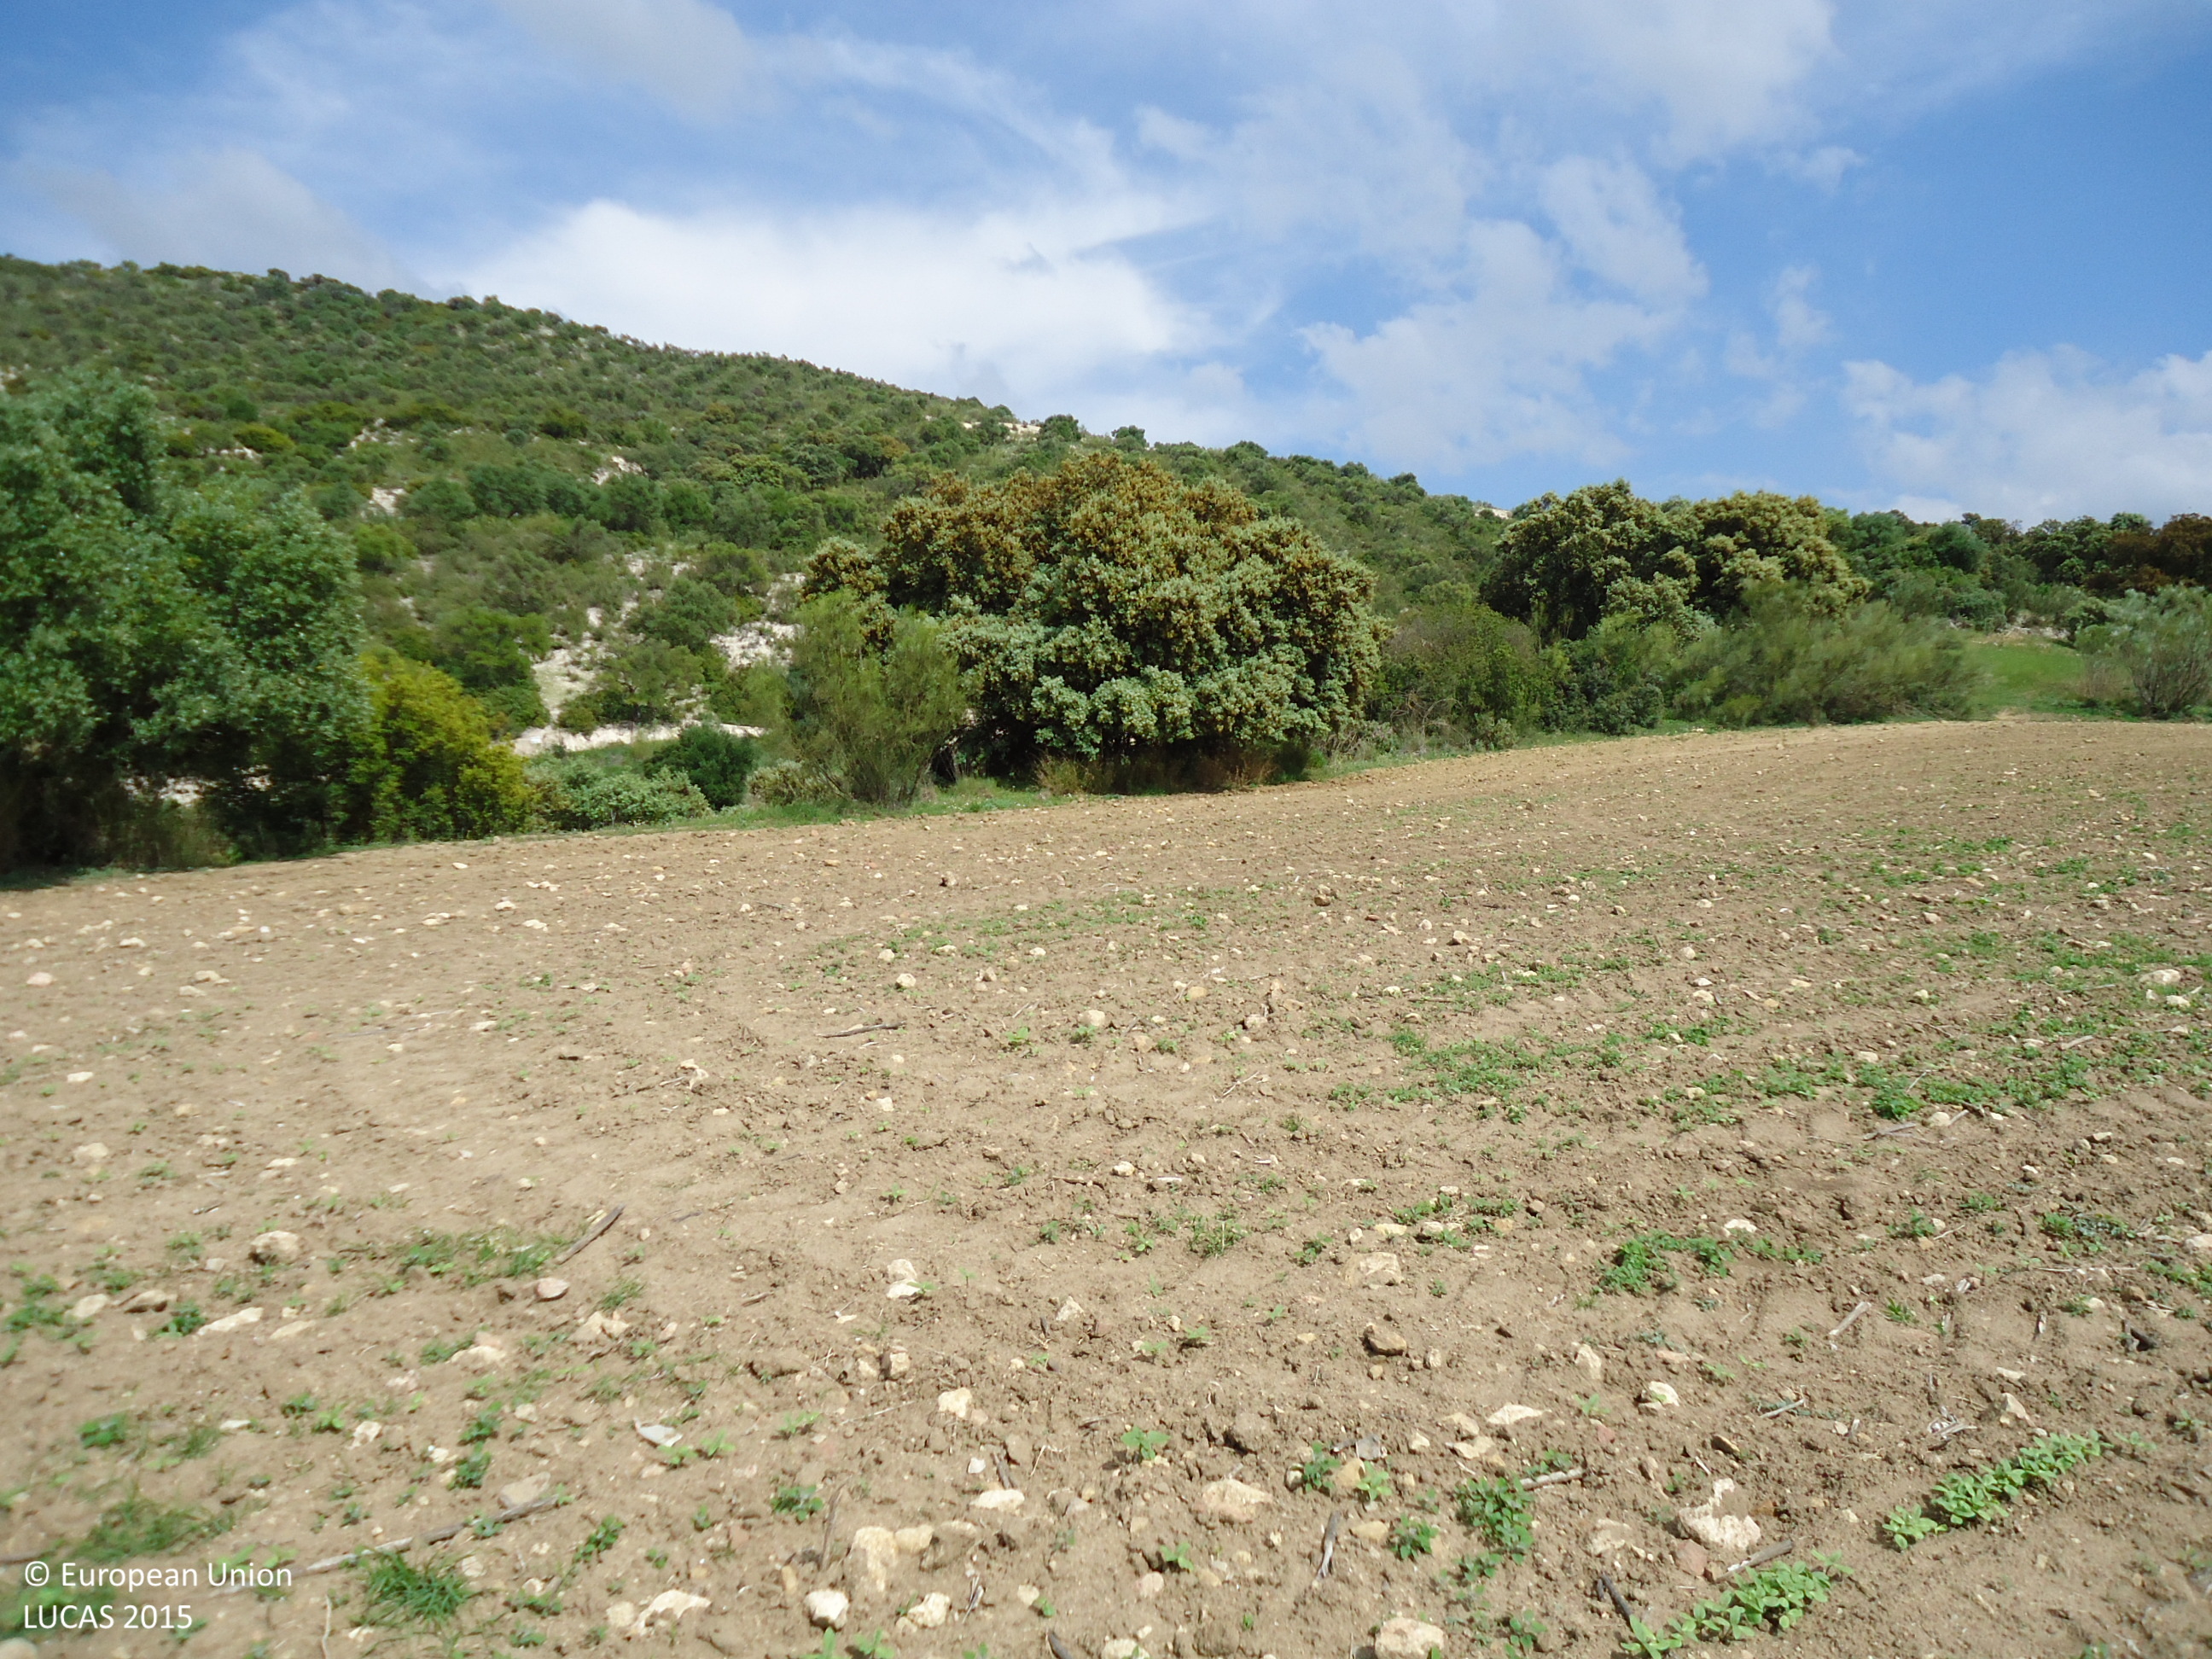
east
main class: Cropland
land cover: Sunflower
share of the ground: < 10 %
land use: Agriculture (excluding fallow land and kitchen gardens)
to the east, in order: Sunflower; Shrubland with sparse tree cover; Grassland with sparse tree/shrub cover; Fences; Tracks; Shrubland with sparse tree cover
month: April
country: ES
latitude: 36.9811
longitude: -5.2952
